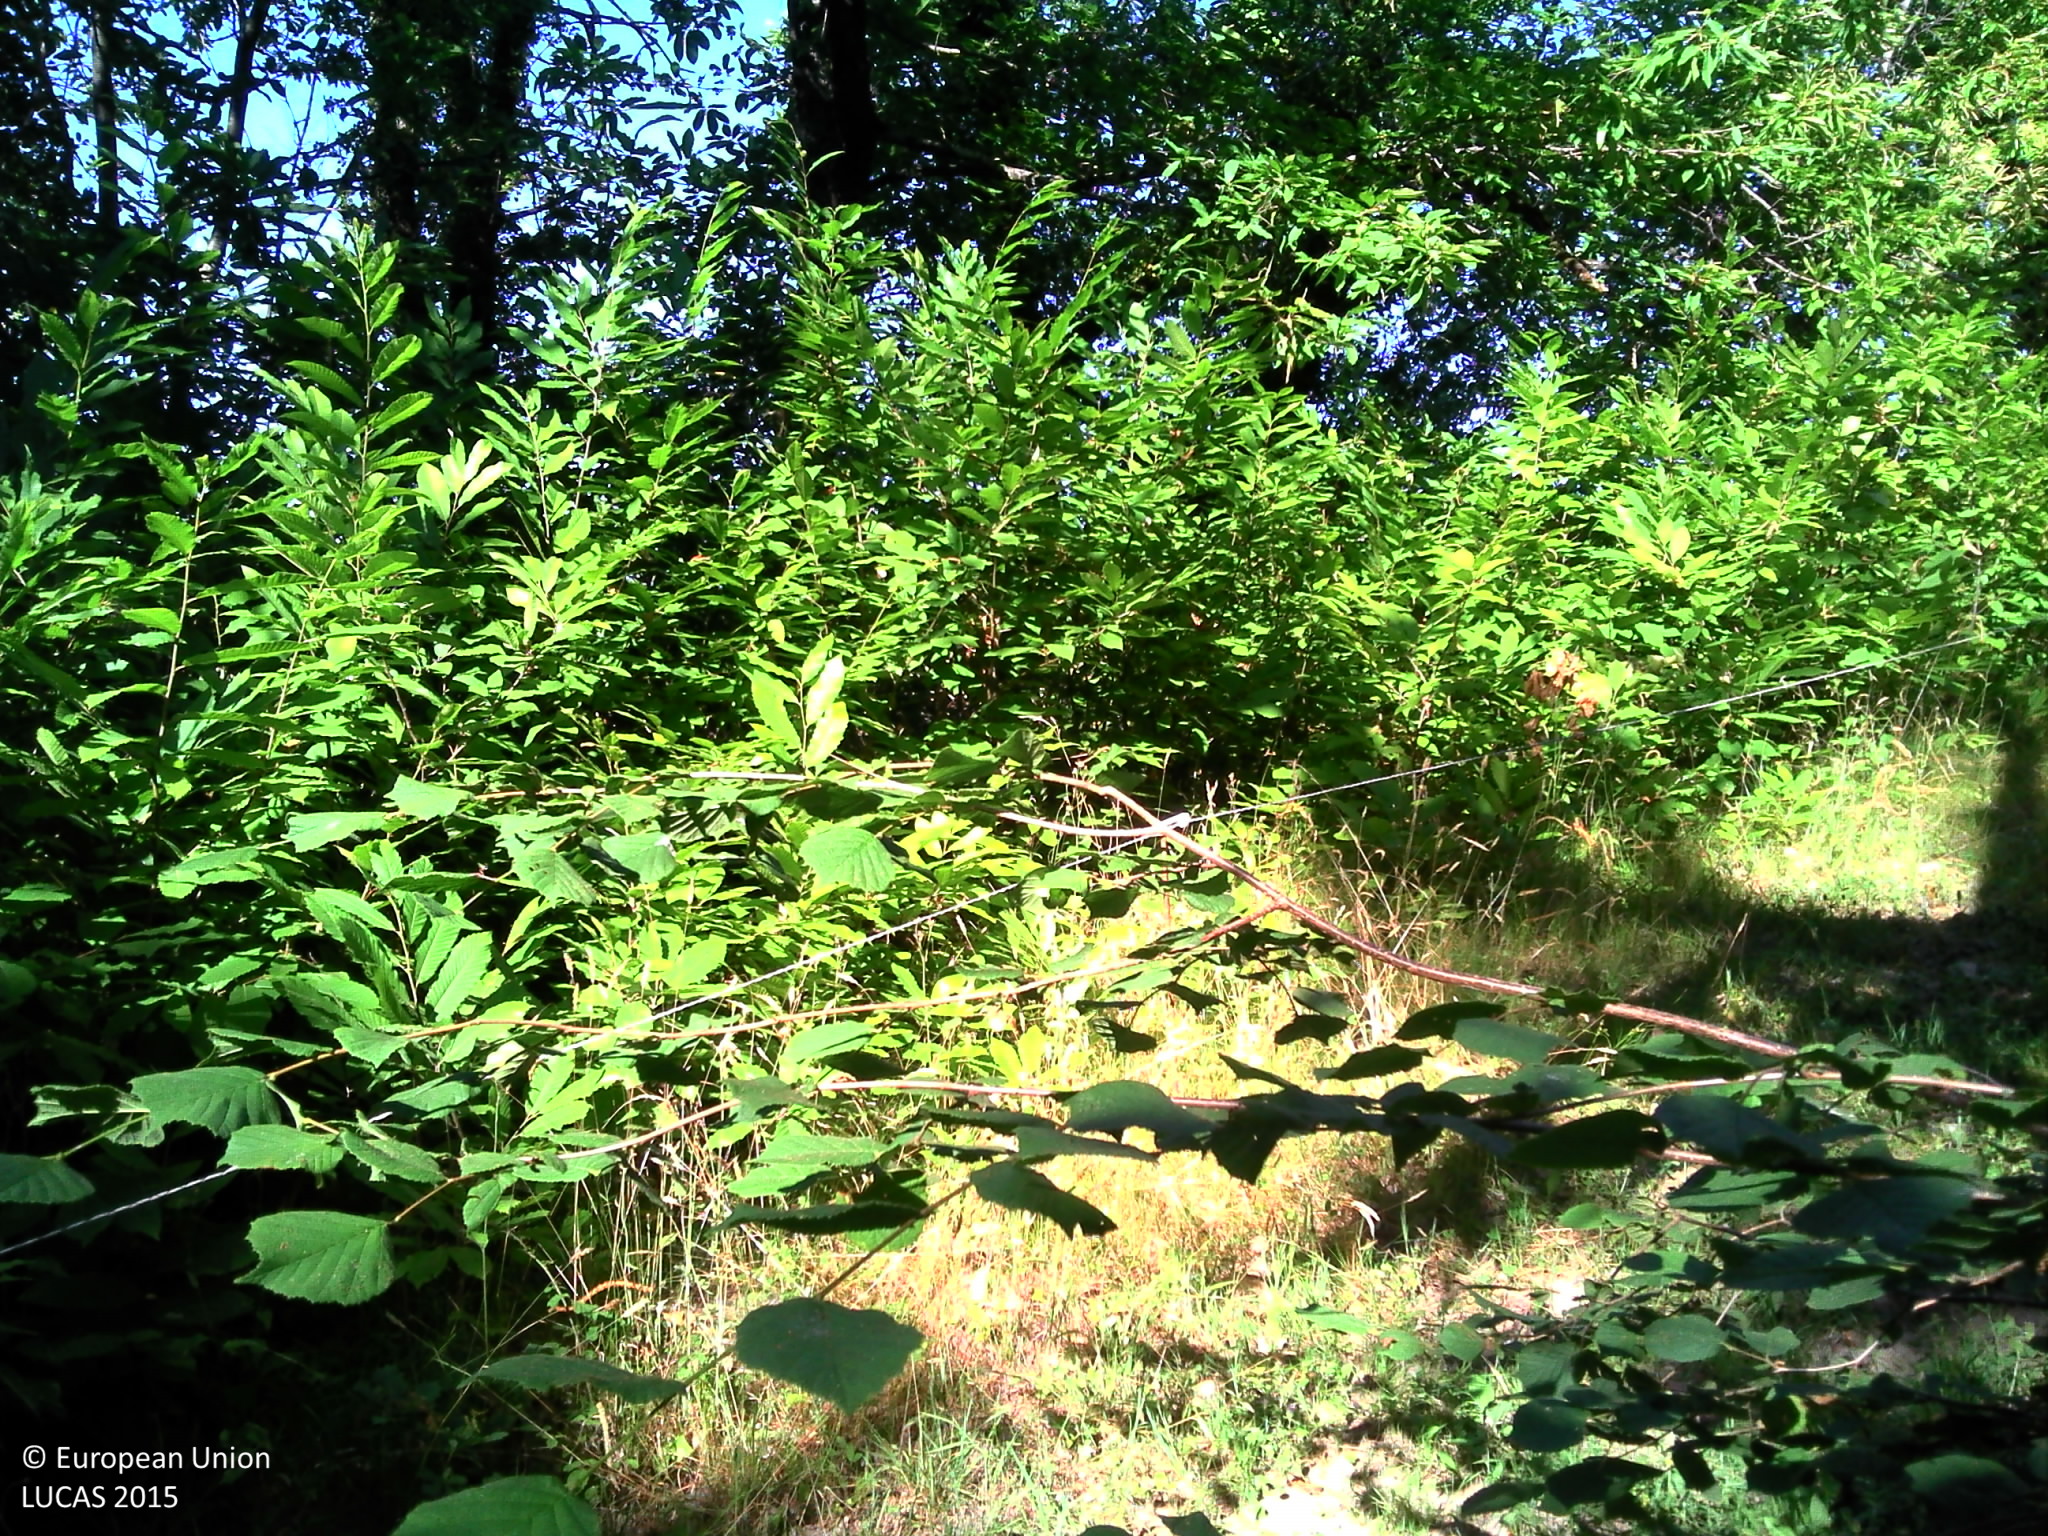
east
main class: Woodland
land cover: Broadleaved woodland
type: thermophilous deciduous forest
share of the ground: > 75 %
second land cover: Spontaneously vegetated surfaces
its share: > 75 %
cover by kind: broadleaved forest trees 80 %, herbaceous plants 15 %, shrubs 5 %
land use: Forestry
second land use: Agriculture (excluding fallow land and kitchen gardens)
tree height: > 5 m
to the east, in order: Broadleaved woodland; Spontaneously vegetated surfaces; Paved roads, cycling and walking lanes; Grassland without tree/shrub cover; Abandoned hedges; Lines of trees; Abandoned hedges; Grassland without tree/shrub cover
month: June
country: FR
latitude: 44.5838
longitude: 0.8881
